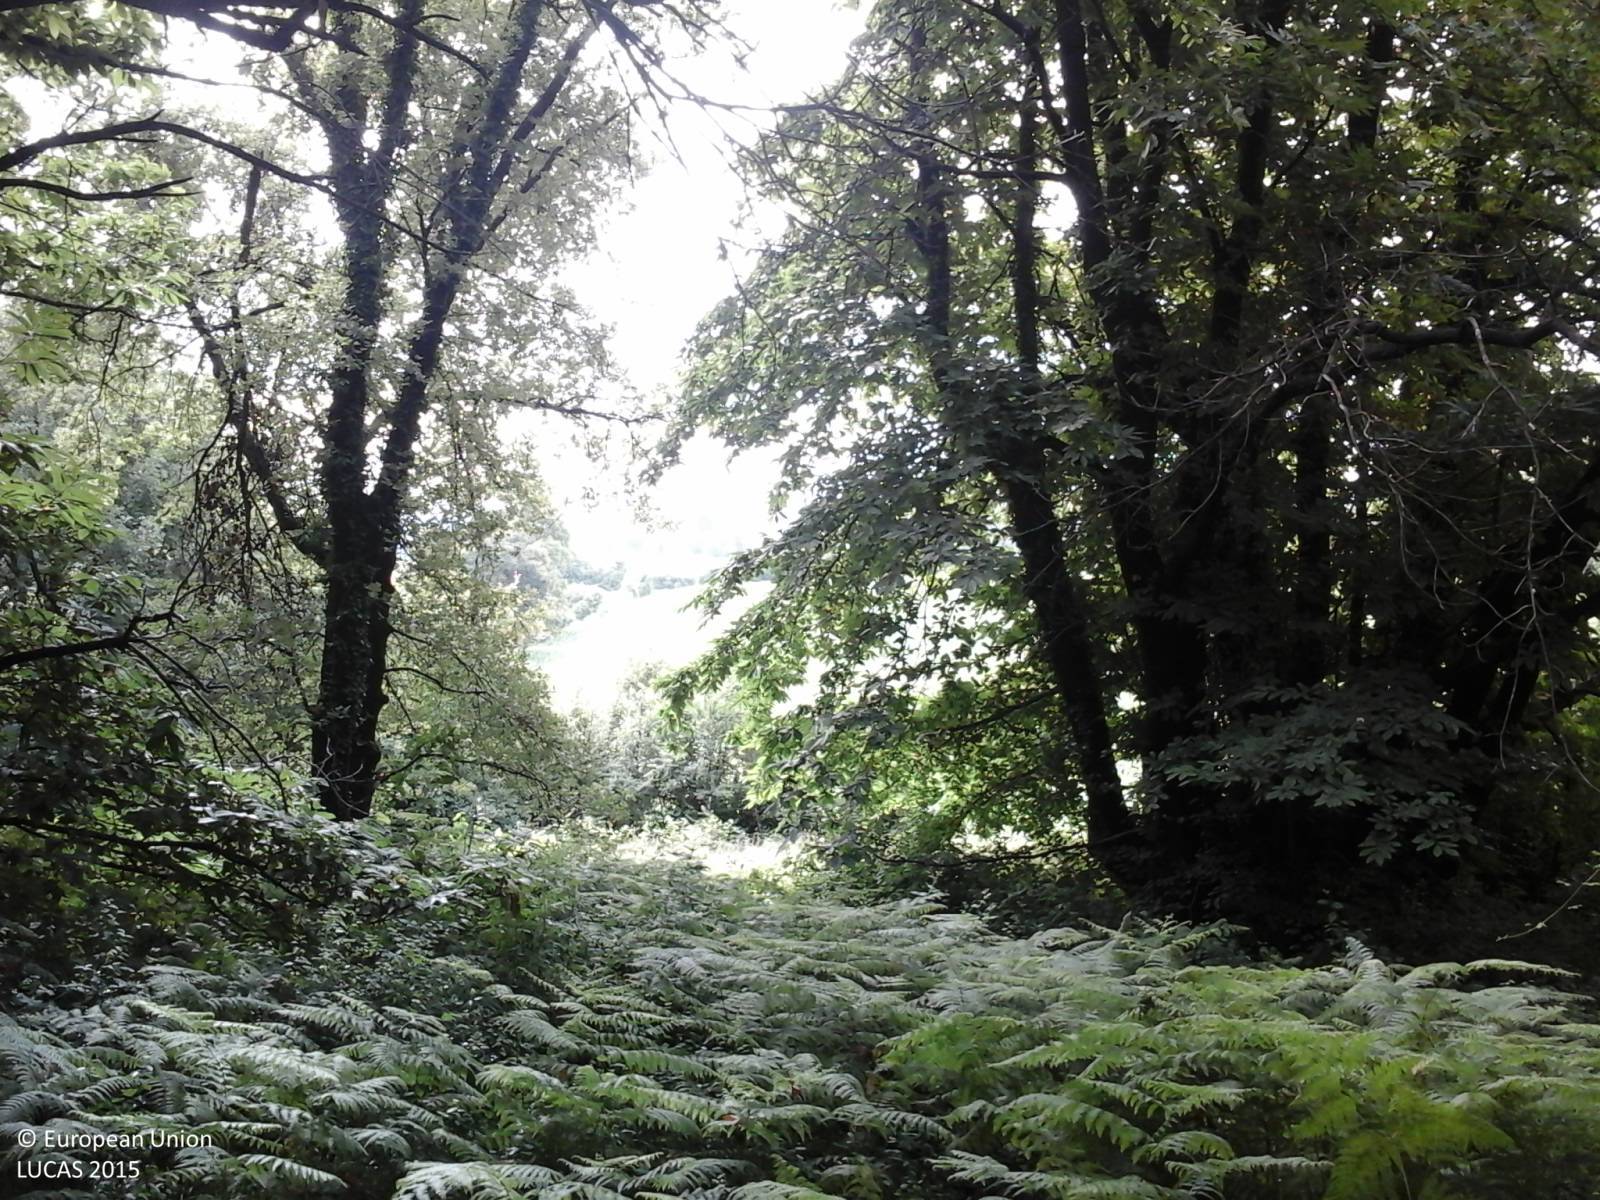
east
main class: Woodland
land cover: Broadleaved woodland
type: thermophilous deciduous forest
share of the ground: > 75 %
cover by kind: broadleaved forest trees 70 %, shrubs 20 %, herbaceous plants 10 %
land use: Forestry
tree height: > 5 m
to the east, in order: Broadleaved woodland; Grassland without tree/shrub cover; Broadleaved woodland; Tracks; Grass margins; Maize; Abandoned hedges; Grass margins; Tracks; Grass margins; Maize
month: June
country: IT
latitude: 46.1458
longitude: 13.0390
